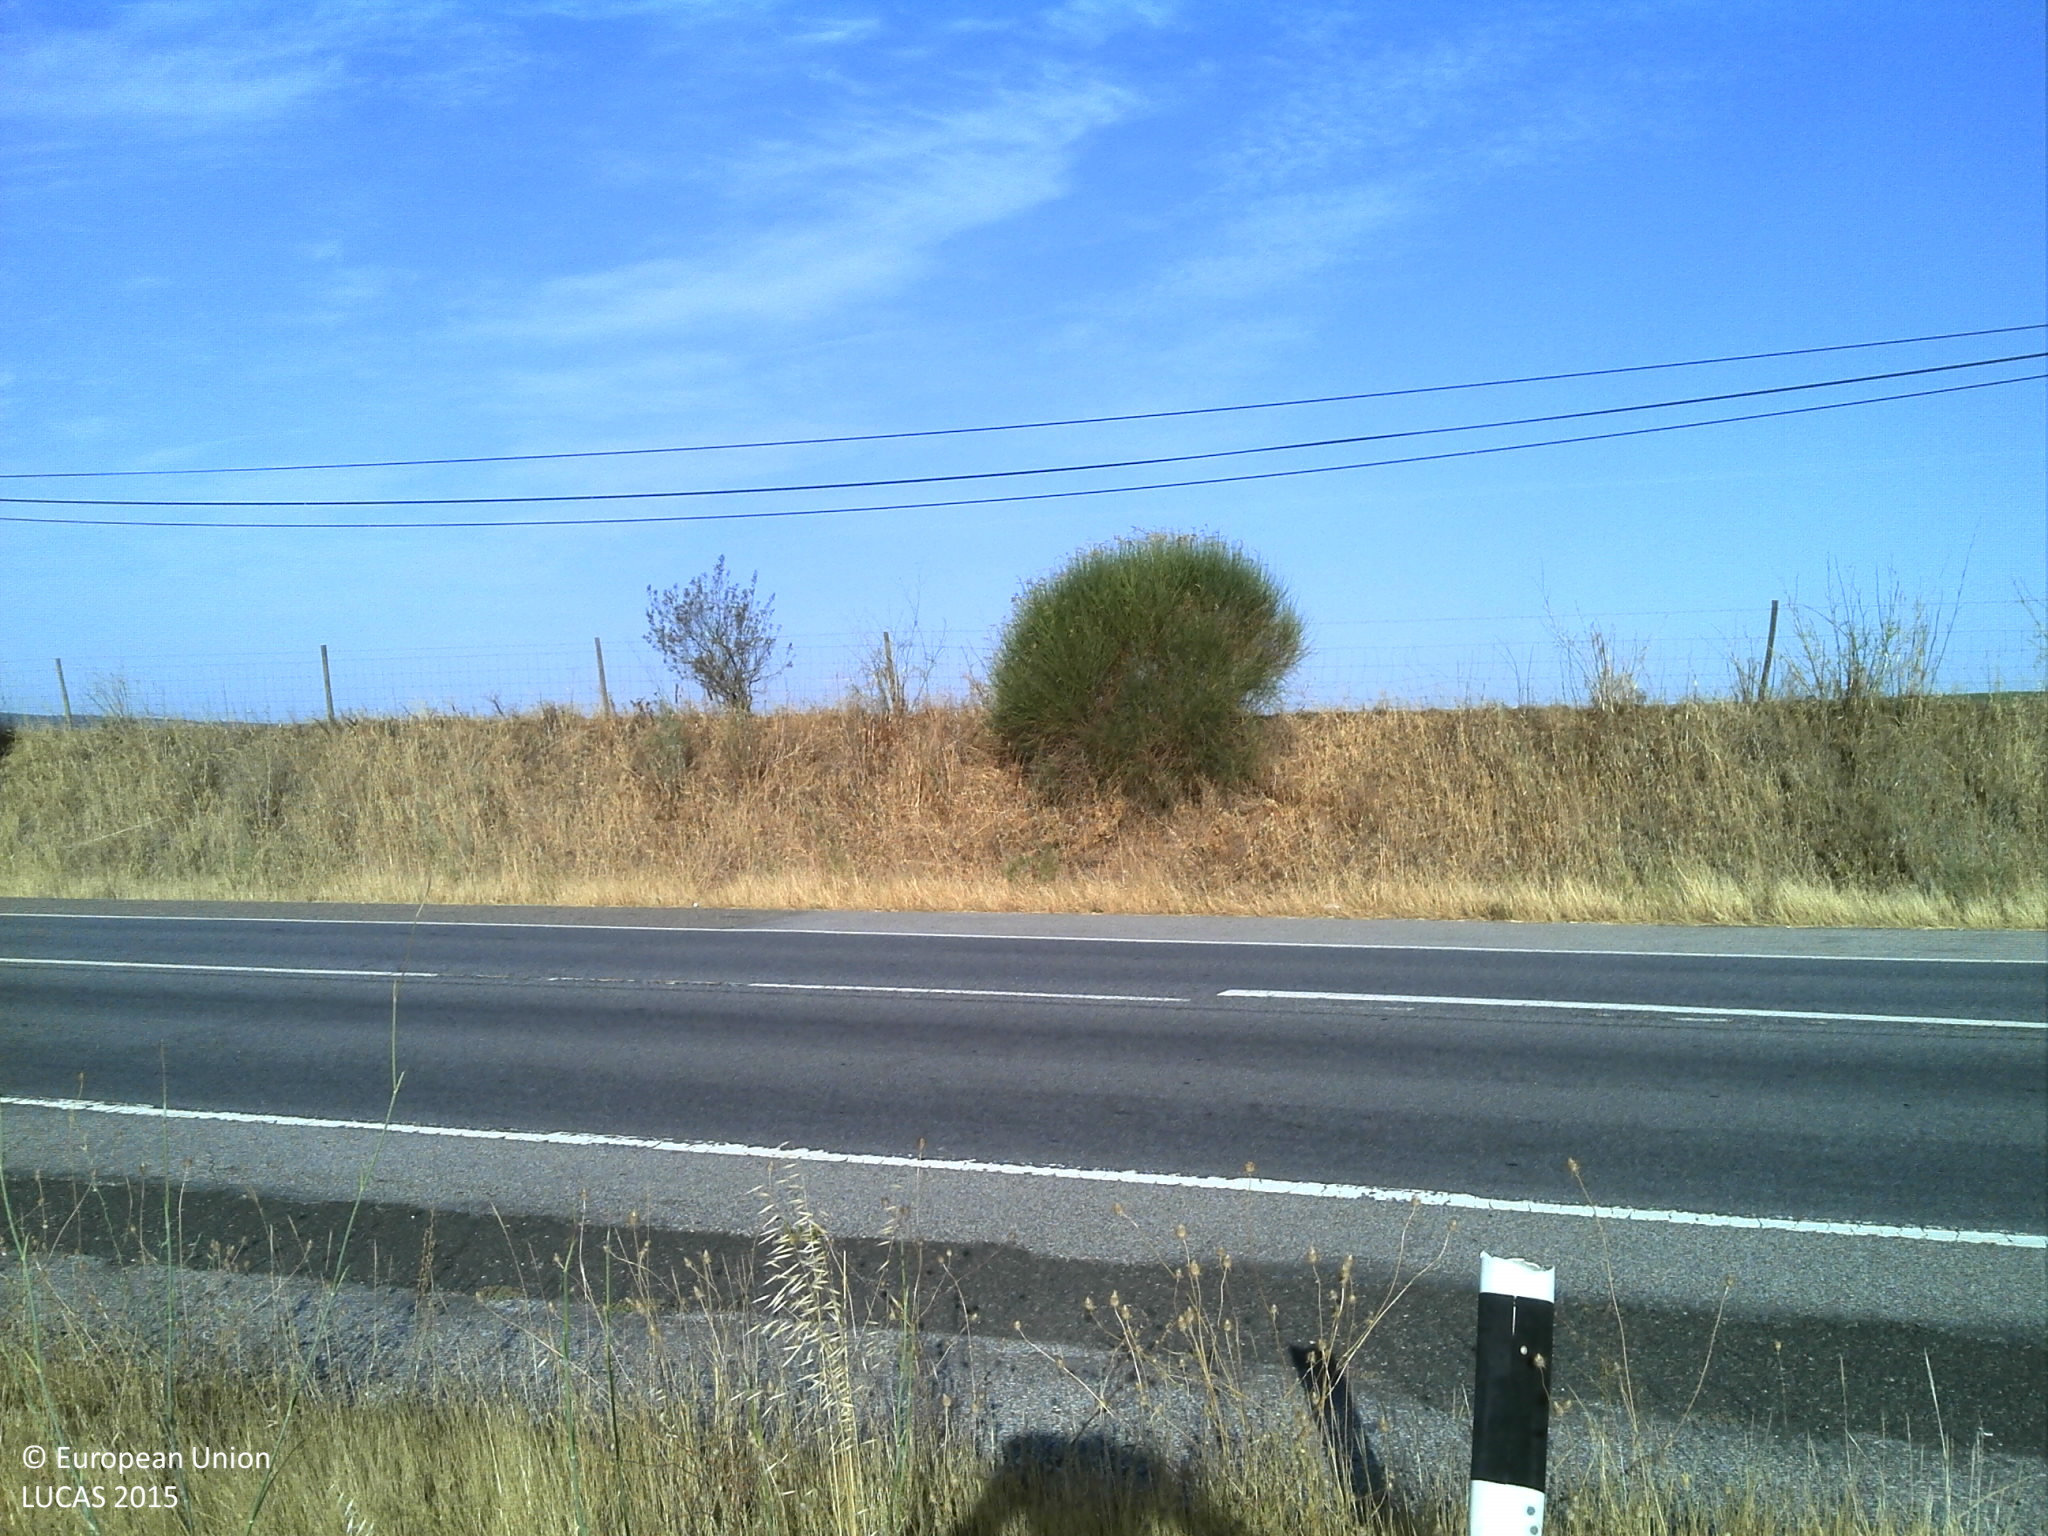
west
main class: Grassland
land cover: Grassland without tree/shrub cover
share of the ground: 50 - 75 %
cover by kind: herbaceous plants 70 %, unconsolidated bare surface 30 %
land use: Road transport
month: July
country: PT
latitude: 38.4870
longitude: -7.7464
